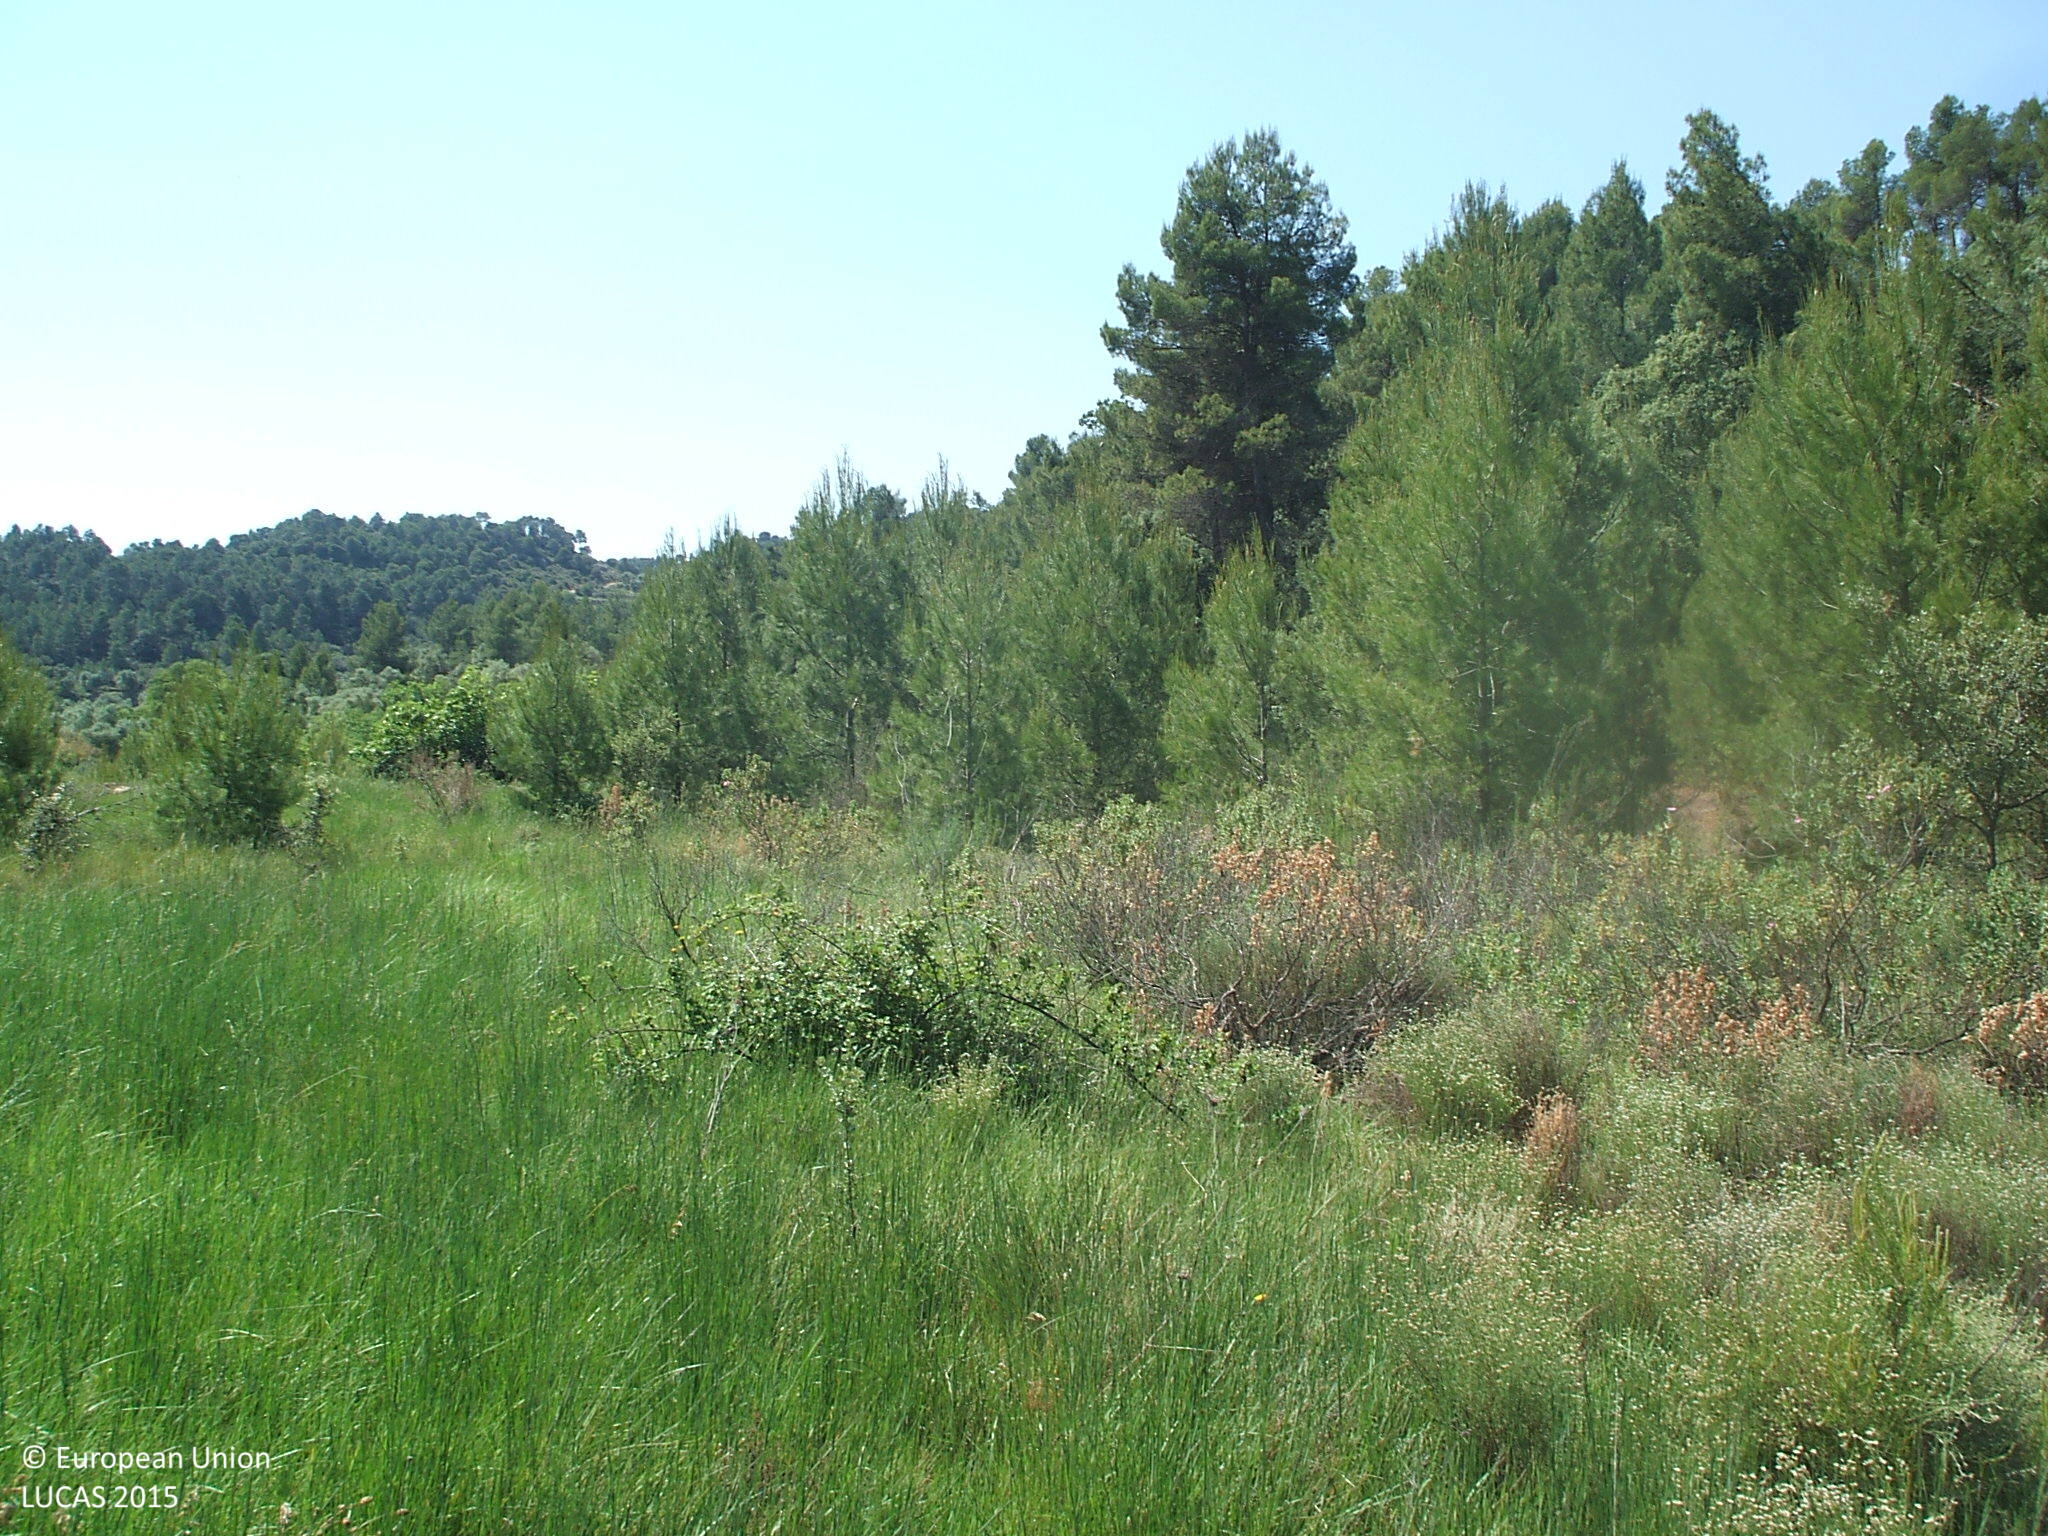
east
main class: Grassland
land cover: Grassland with sparse tree/shrub cover
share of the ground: > 75 %
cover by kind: herbaceous plants 95 %, coniferous forest trees 5 %
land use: Semi-natural and natural areas not in use
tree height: > 5 m
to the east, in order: Grassland with sparse tree/shrub cover; Pine dominated mixed woodland; Pine dominated coniferous woodland; Tracks; Pine dominated coniferous woodland
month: June
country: ES
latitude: 40.9009
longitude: -0.0164
